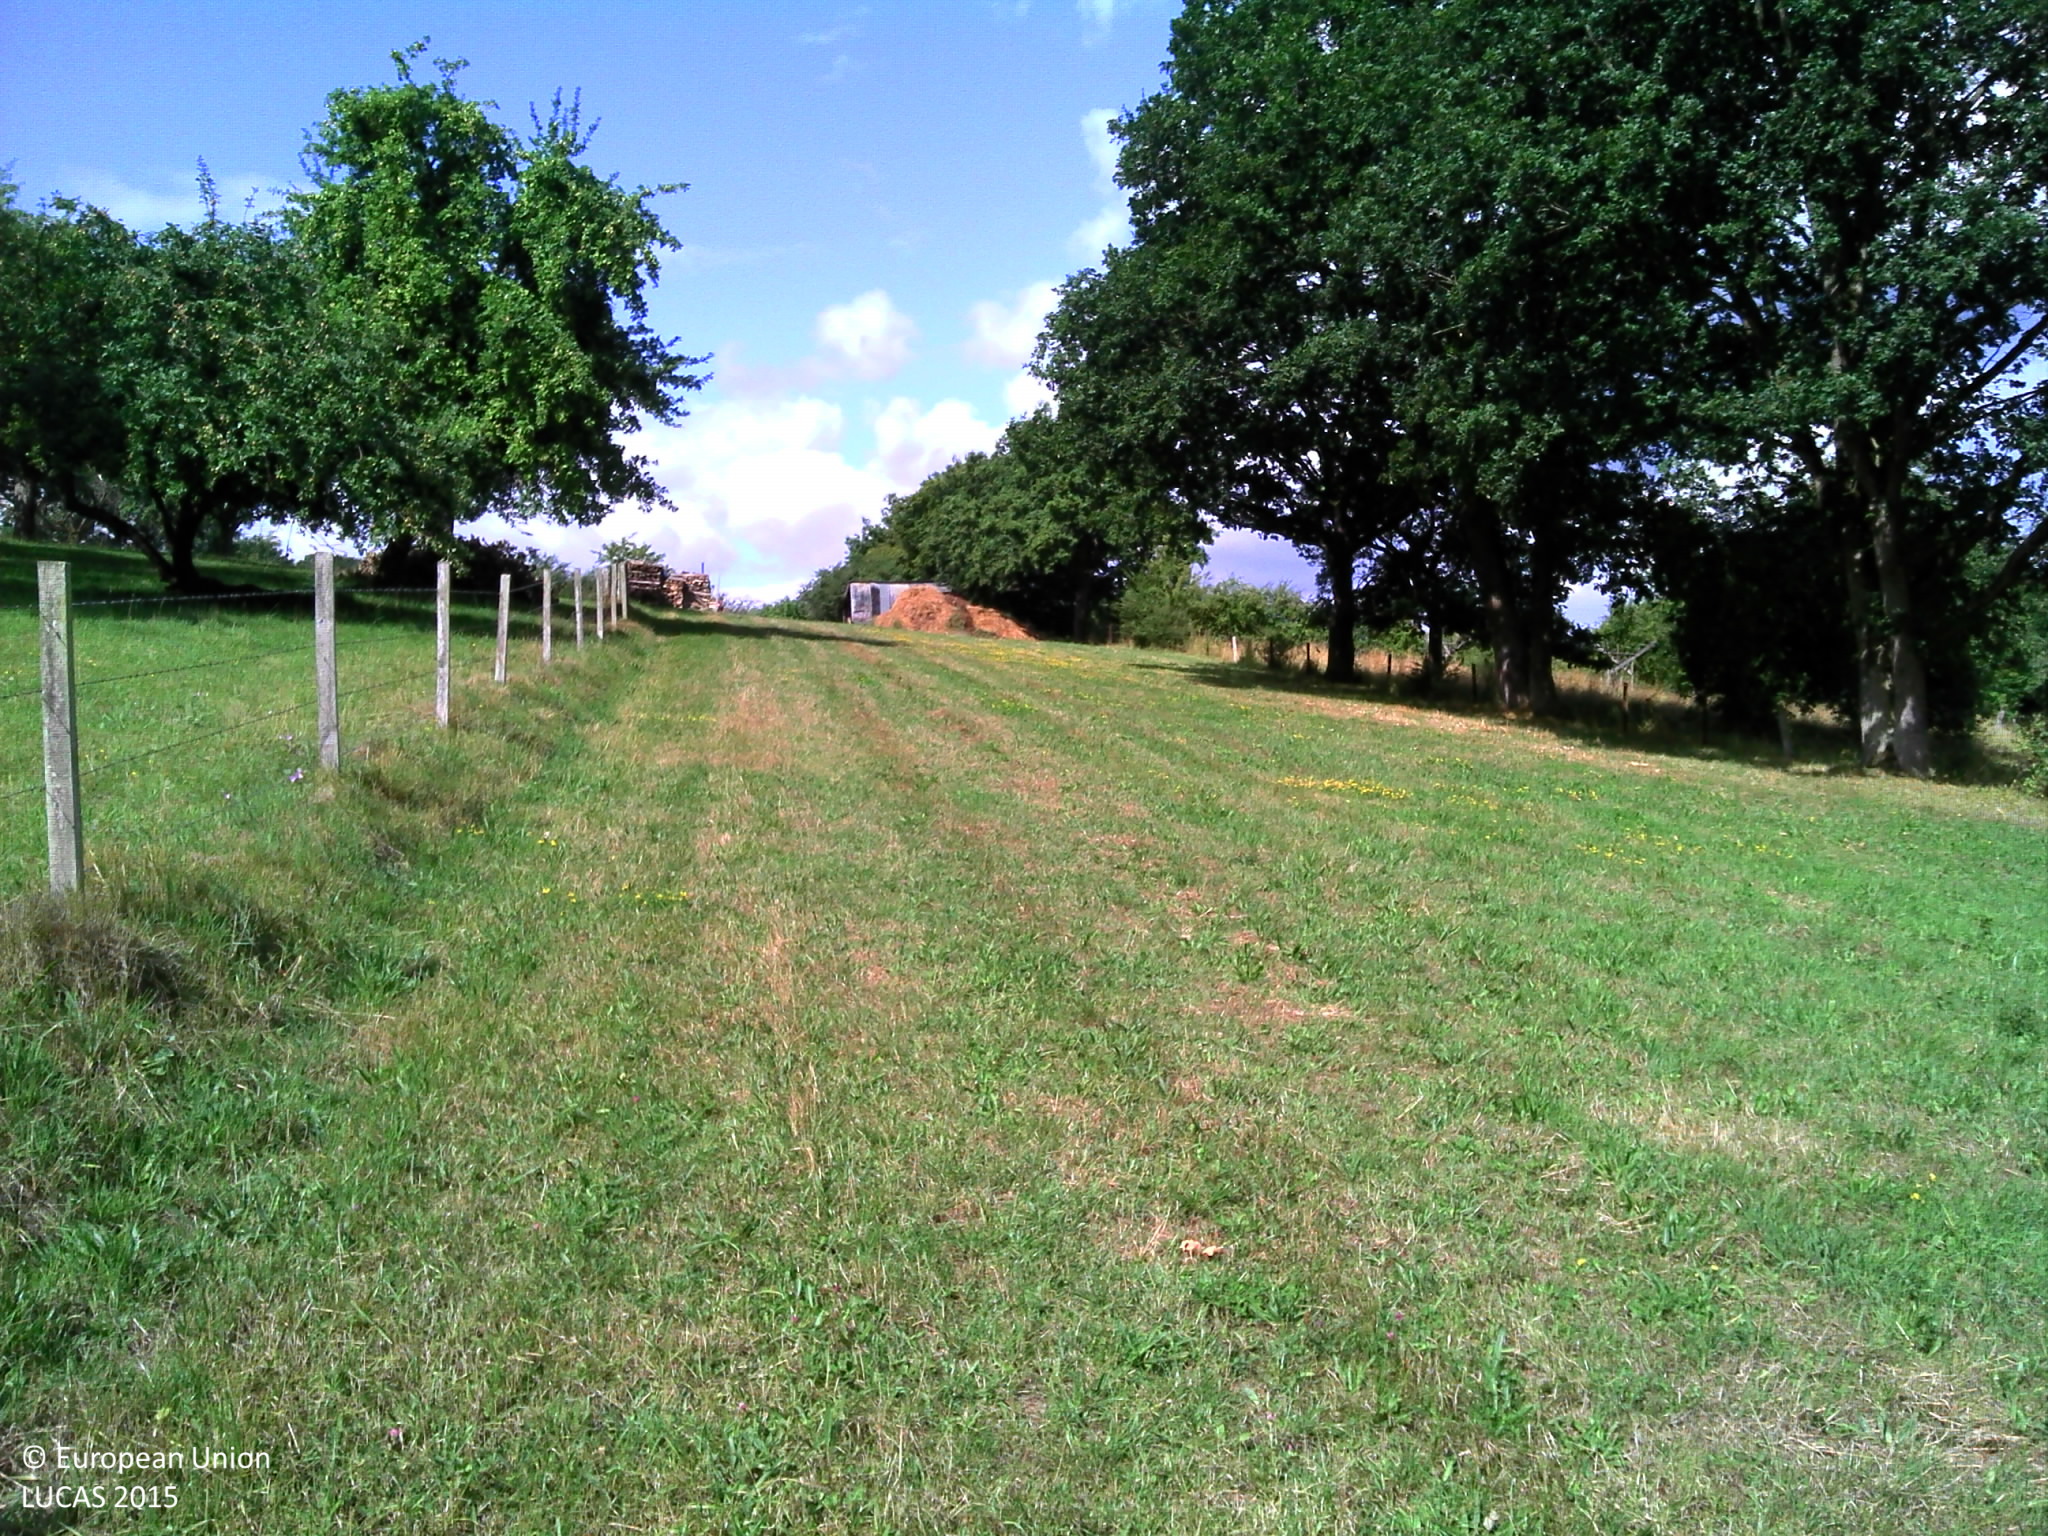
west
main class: Grassland
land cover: Grassland without tree/shrub cover
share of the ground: > 75 %
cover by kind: herbaceous plants 100 %
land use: Agriculture (excluding fallow land and kitchen gardens)
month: July
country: BE
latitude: 49.5765
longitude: 5.5870
